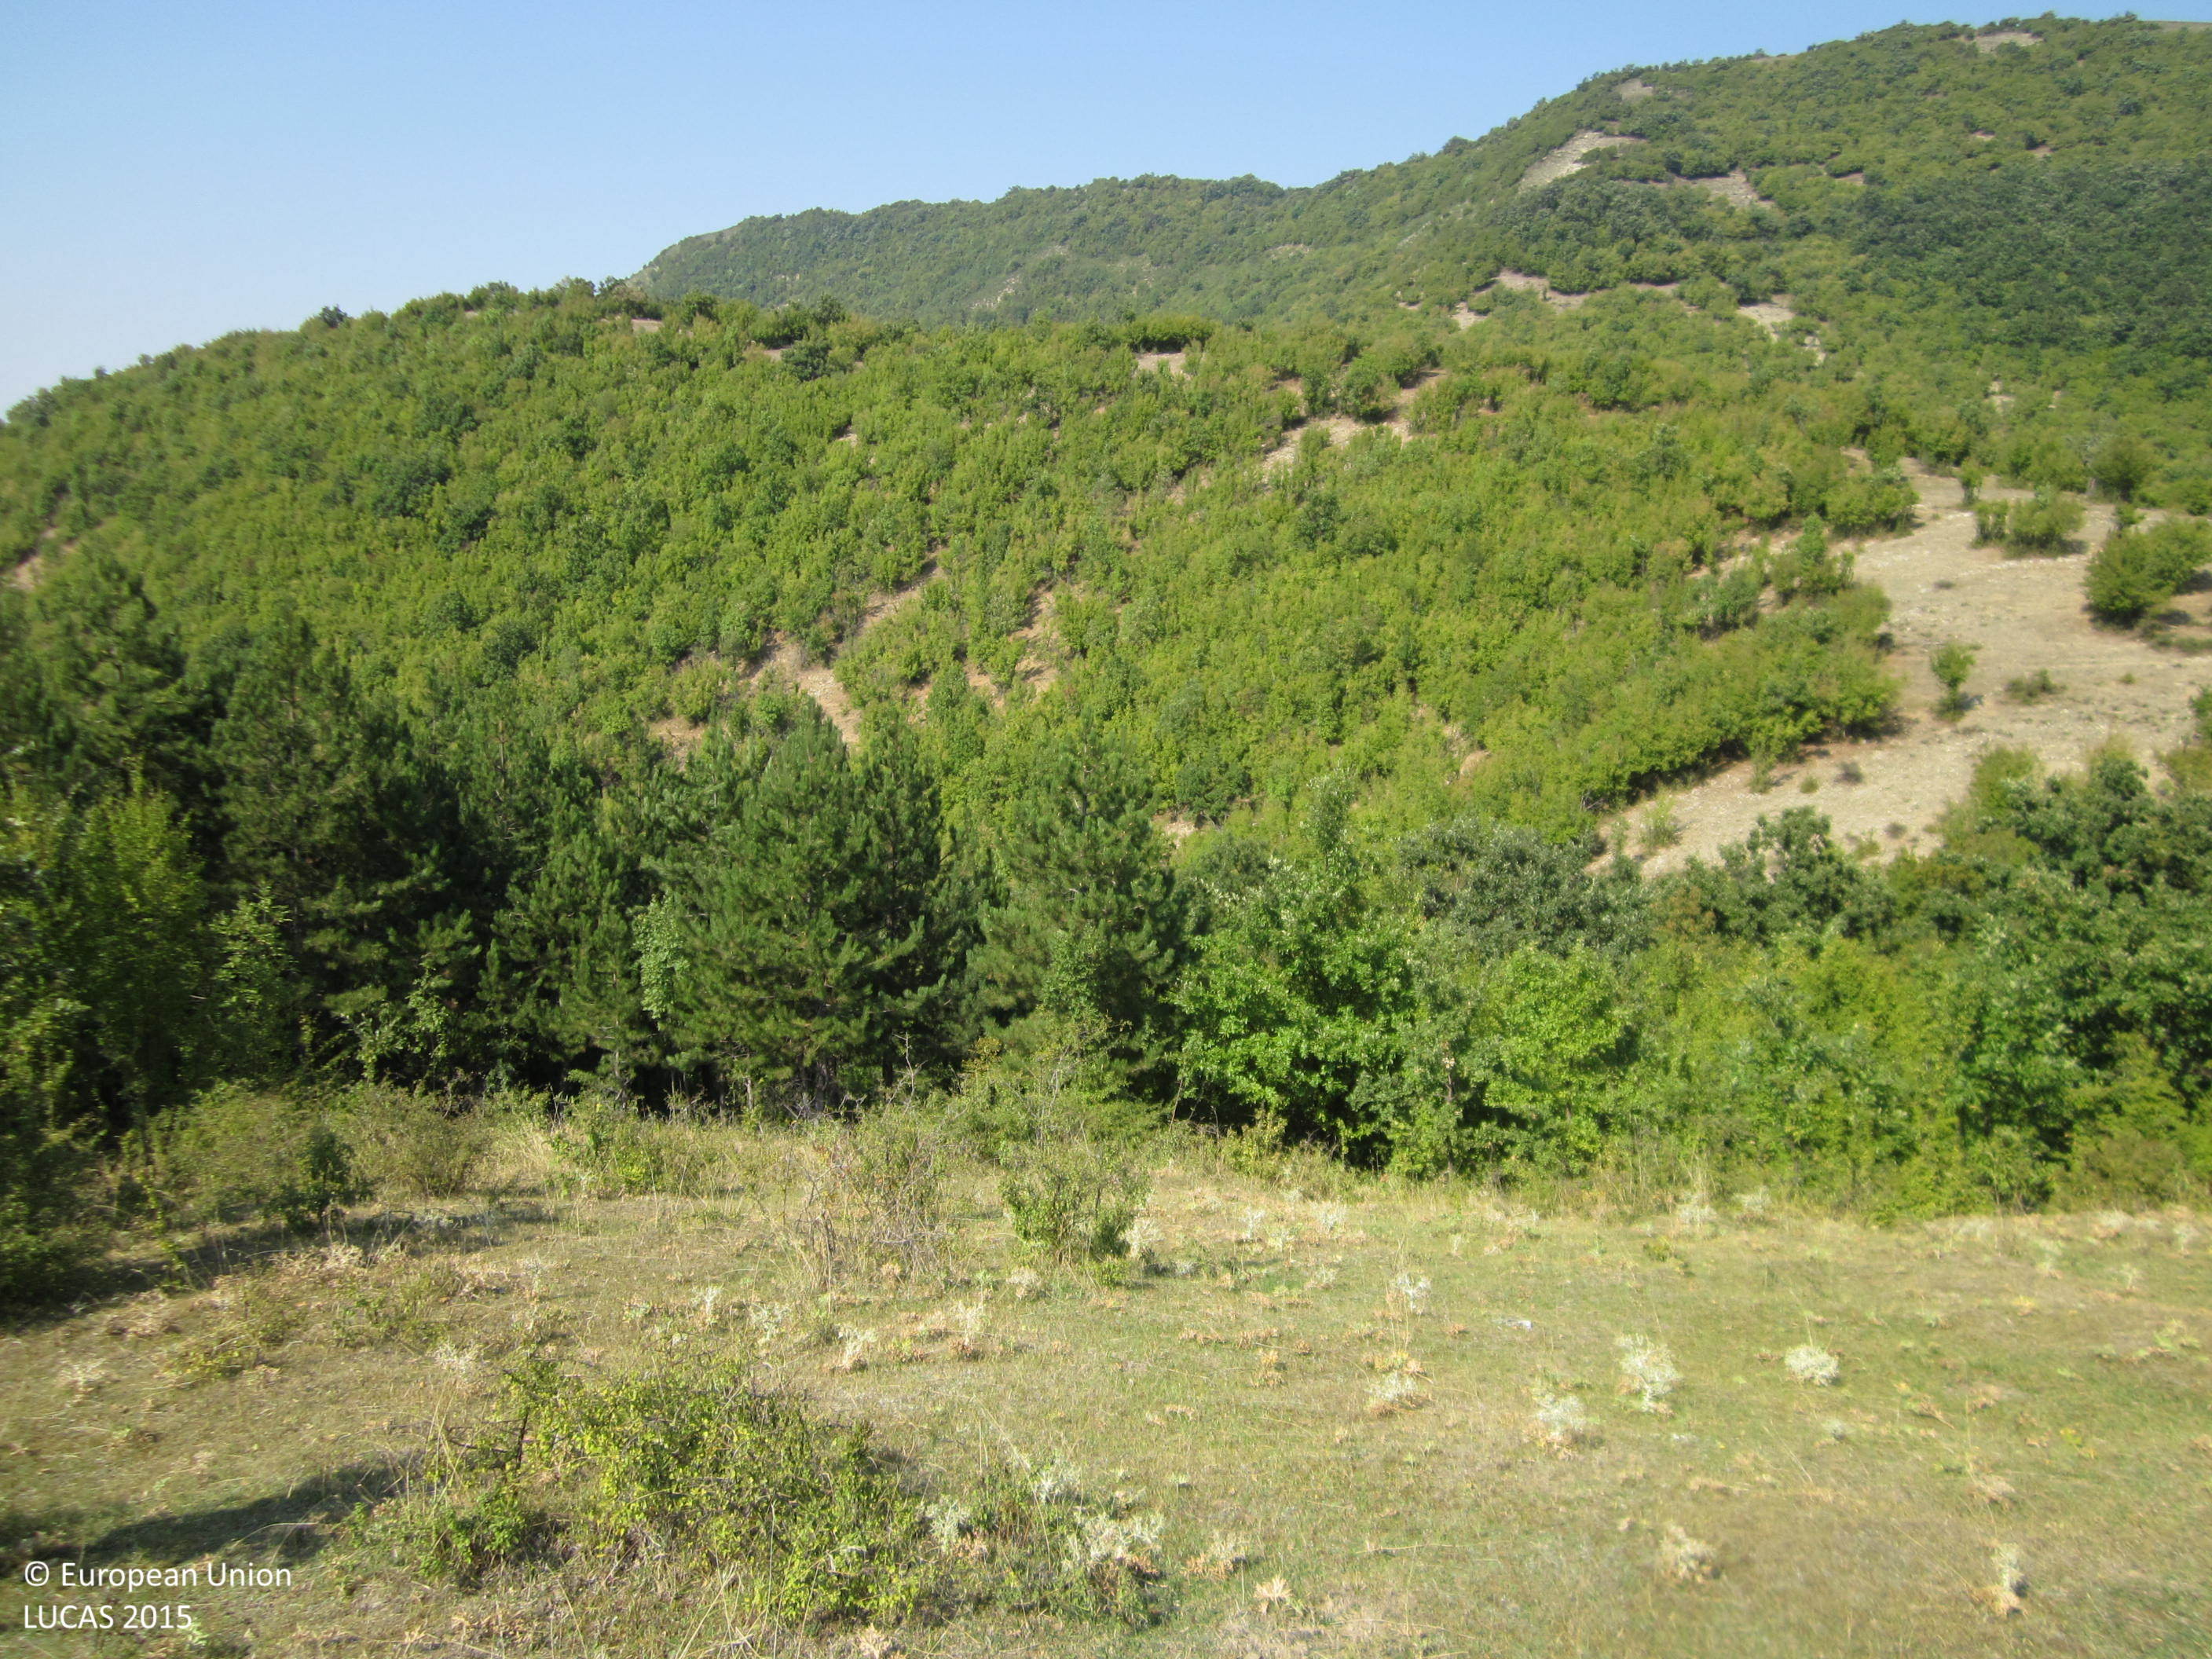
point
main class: Woodland
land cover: Broadleaved woodland
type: mesophytic deciduous forest
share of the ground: > 75 %
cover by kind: broadleaved forest trees 85 %, herbaceous plants 15 %
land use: Forestry
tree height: > 5 m
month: September
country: BG
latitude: 42.9310
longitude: 27.1332
